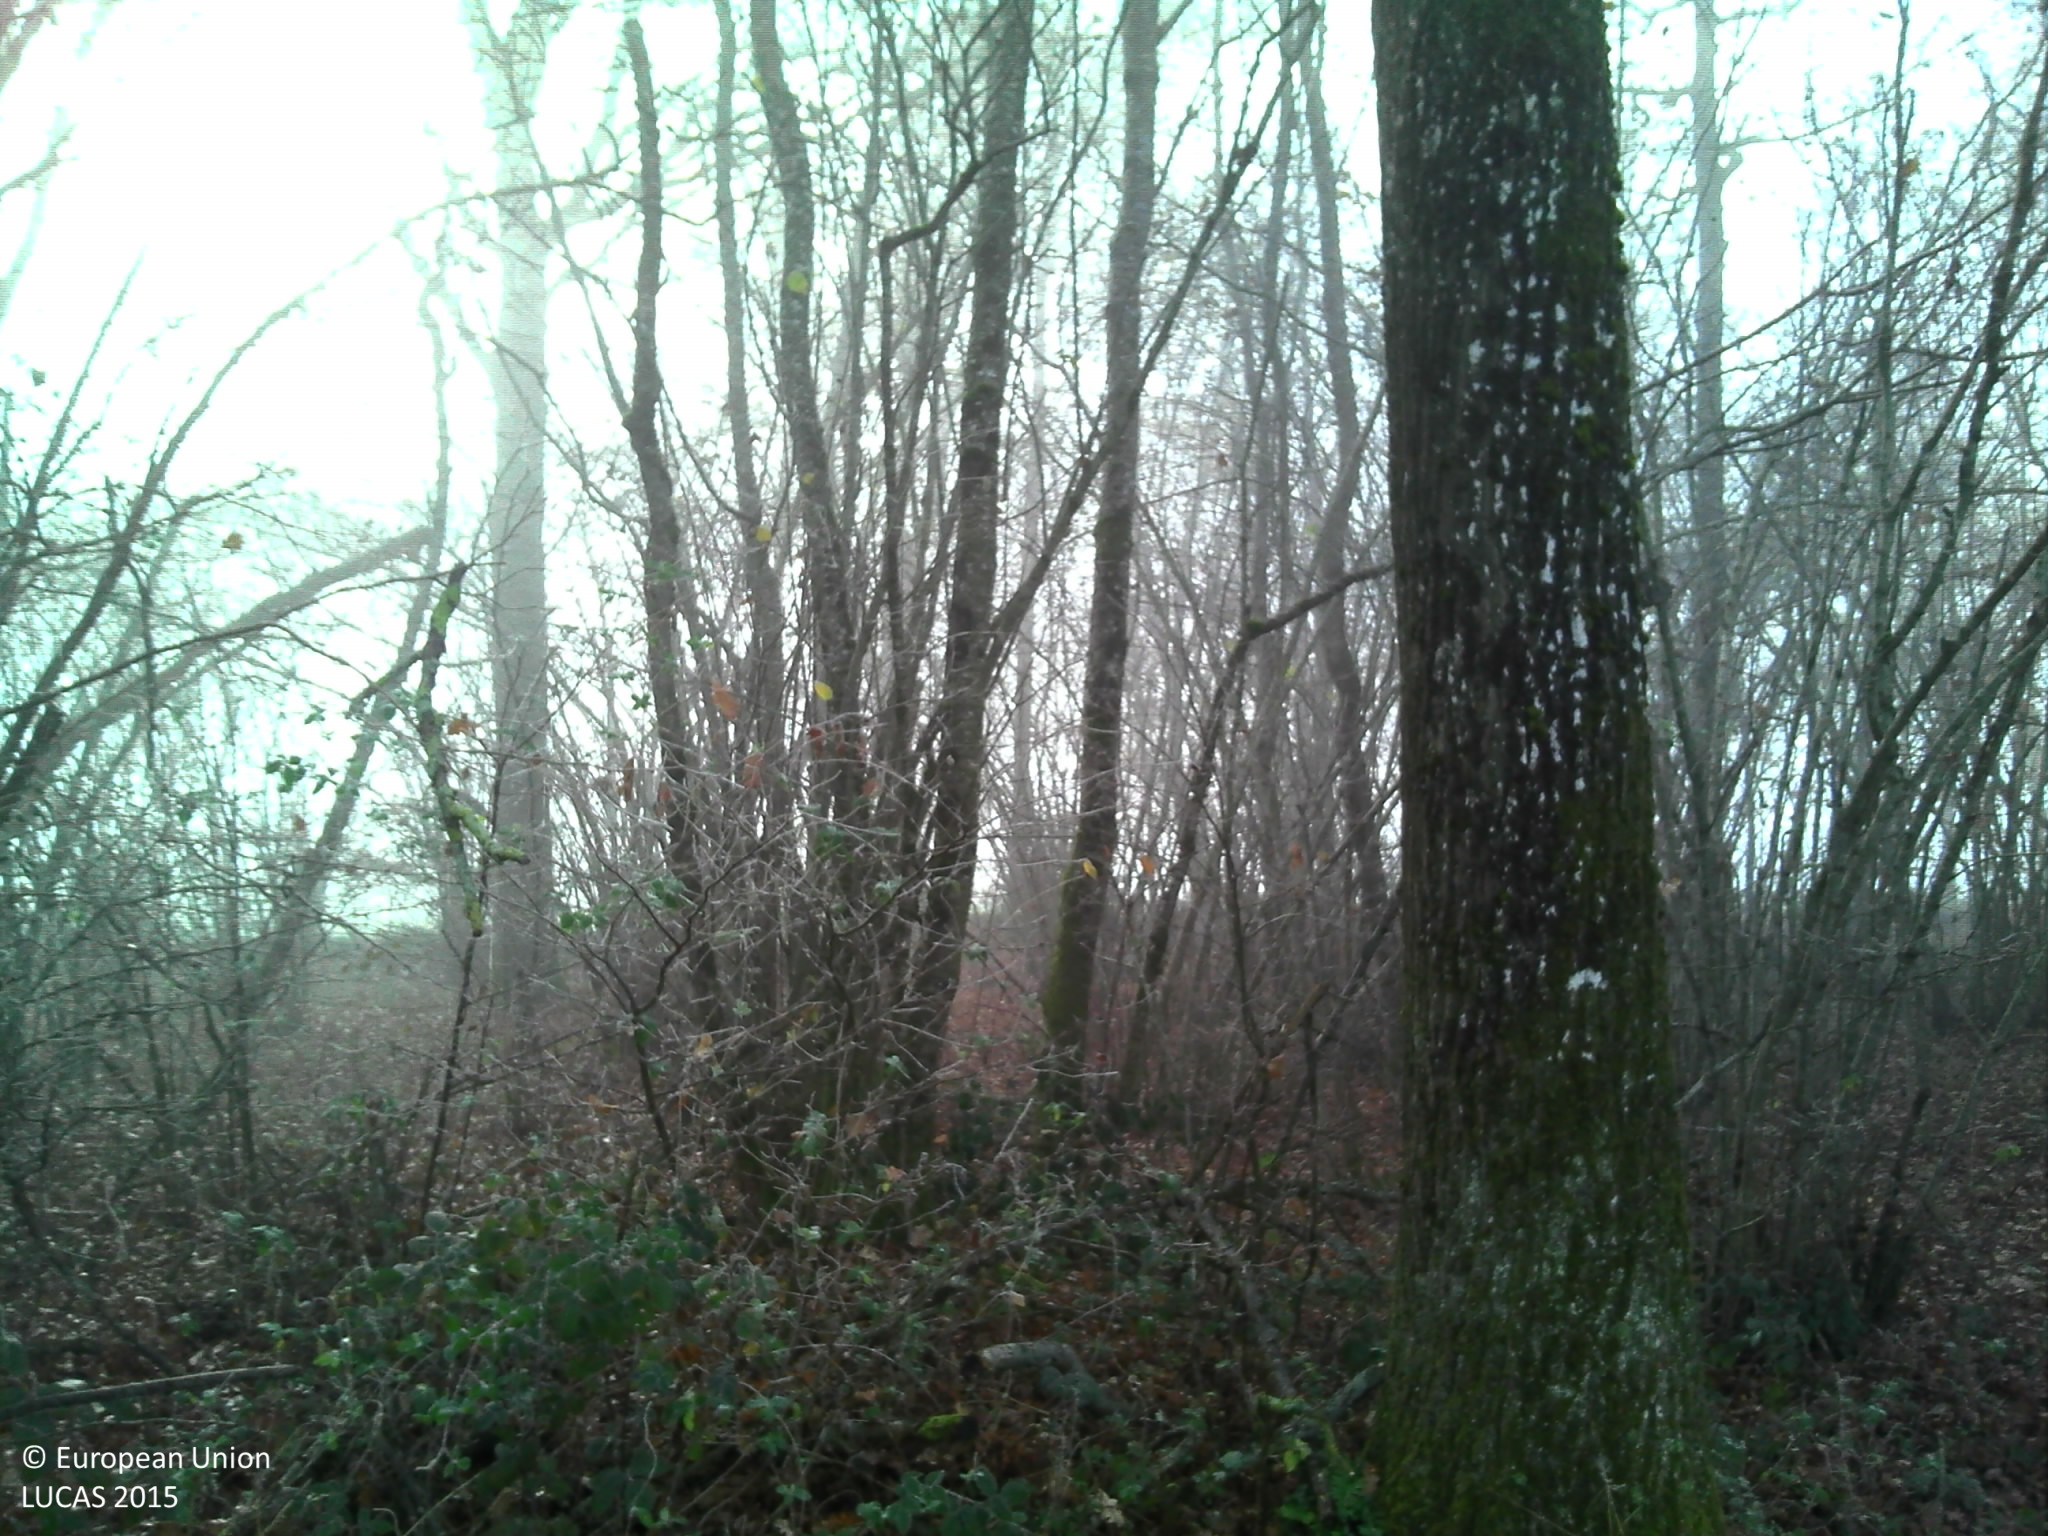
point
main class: Woodland
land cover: Broadleaved woodland
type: mesophytic deciduous forest
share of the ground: > 75 %
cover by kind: broadleaved forest trees 90 %, herbaceous plants 10 %
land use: Agriculture (excluding fallow land and kitchen gardens)
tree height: > 5 m
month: December
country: FR
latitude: 46.4036
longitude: 5.1508
